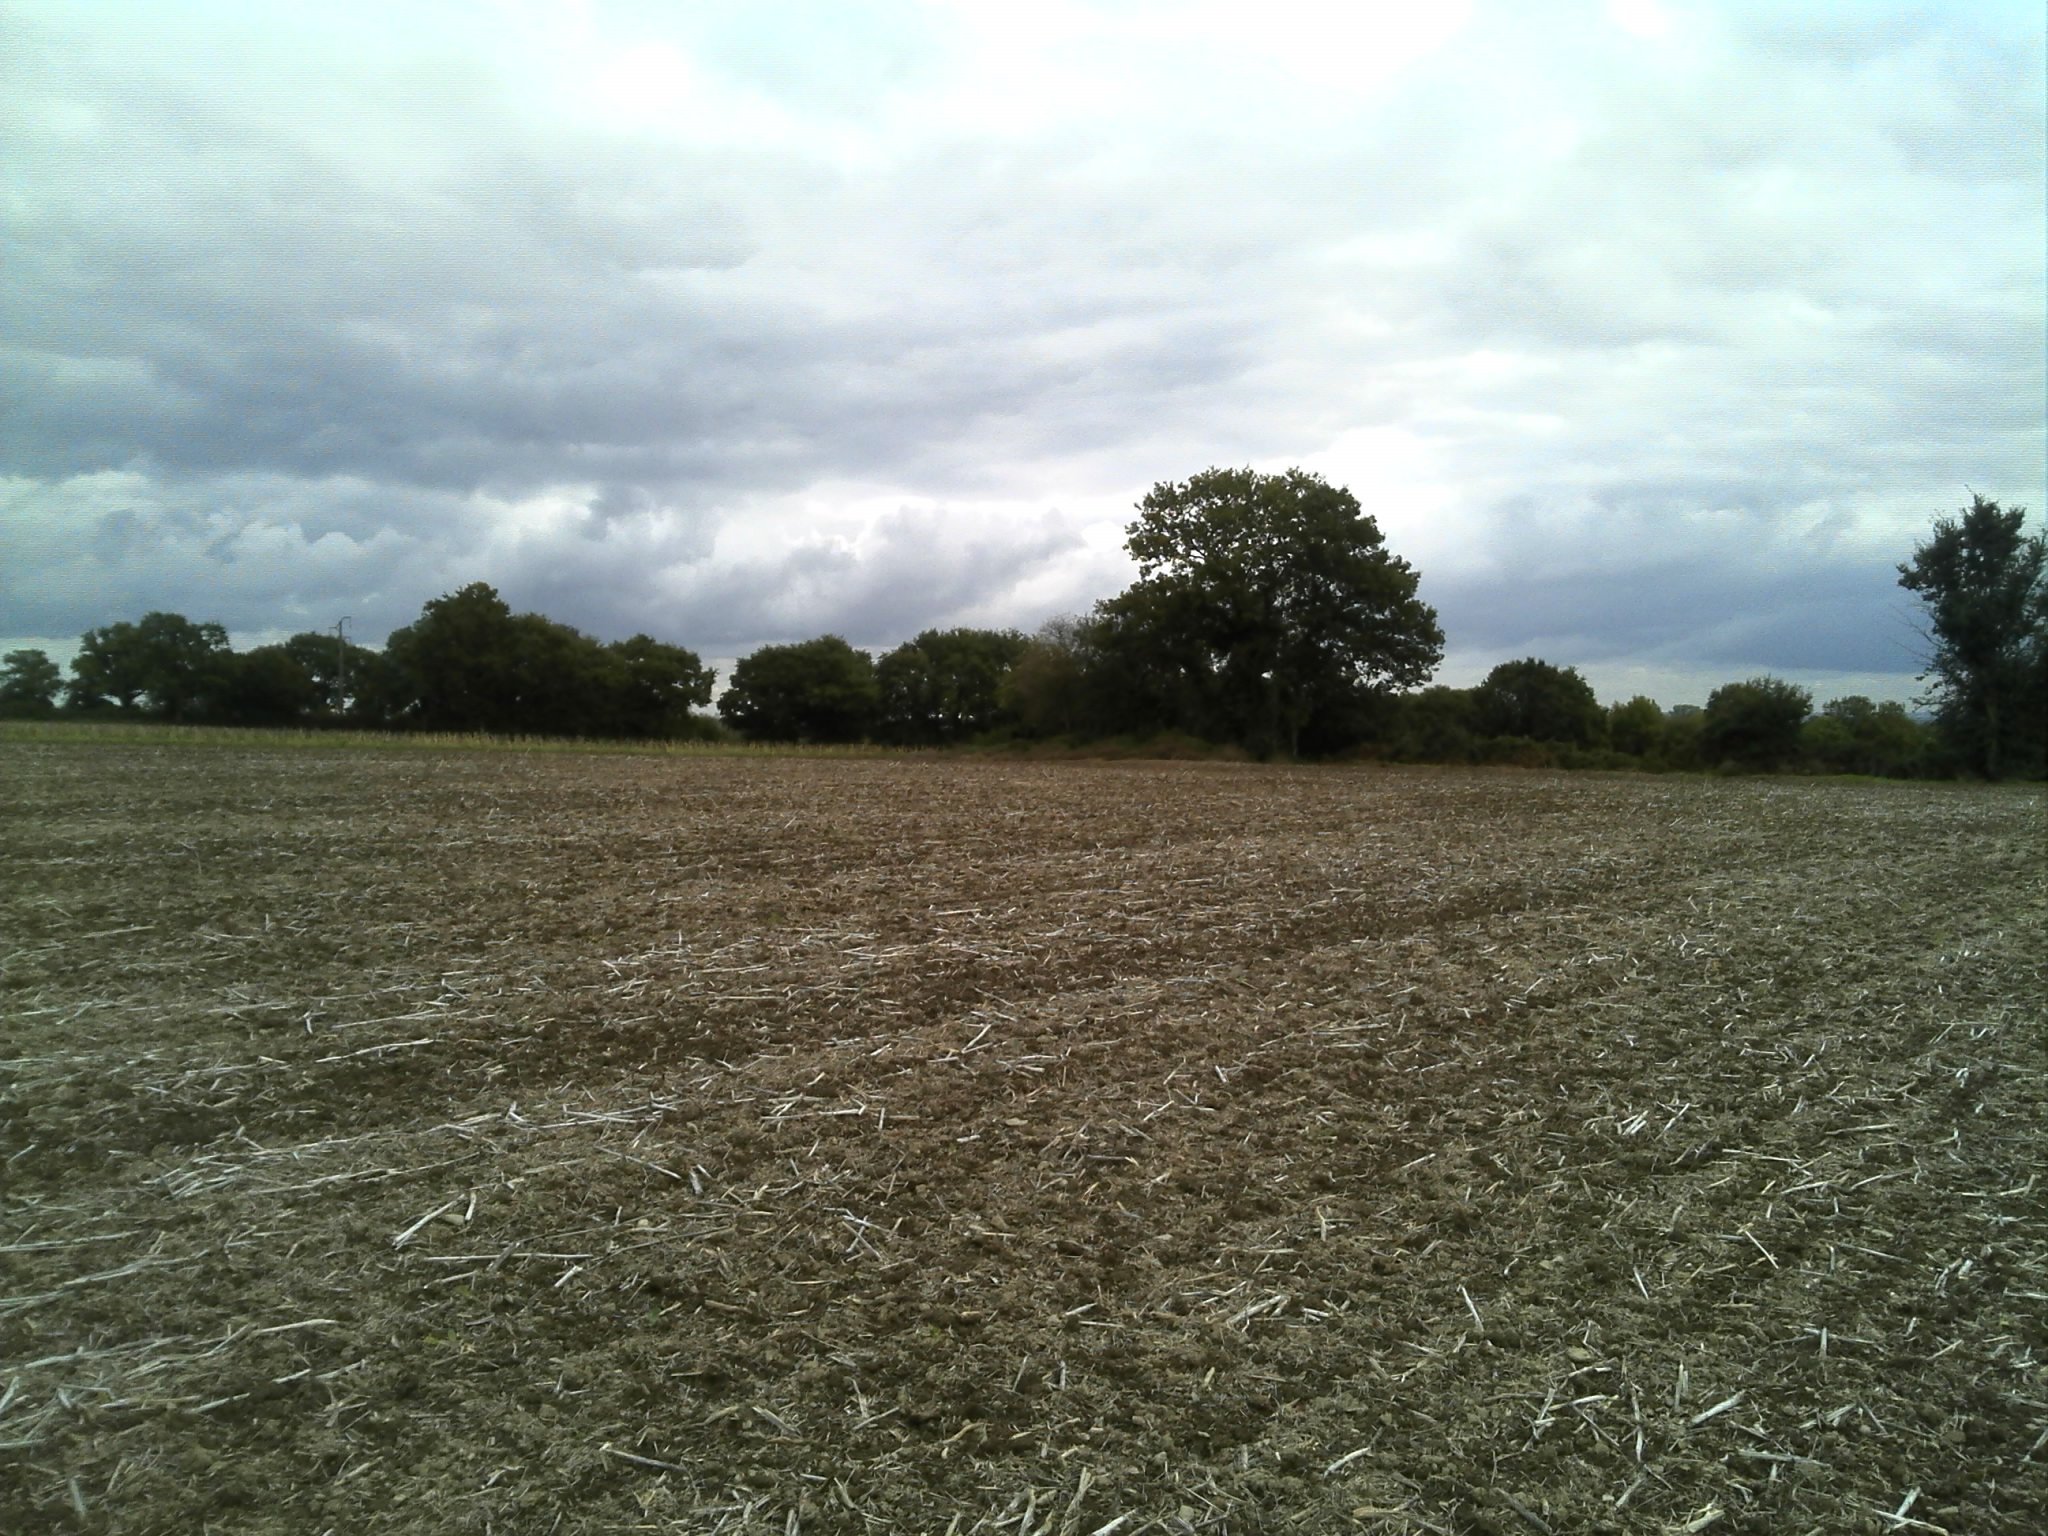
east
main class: Cropland
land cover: Rape and turnip rape
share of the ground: < 10 %
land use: Agriculture (excluding fallow land and kitchen gardens)
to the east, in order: Rape and turnip rape; Sunflower
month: October
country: FR
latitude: 48.1551
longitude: -0.1253
